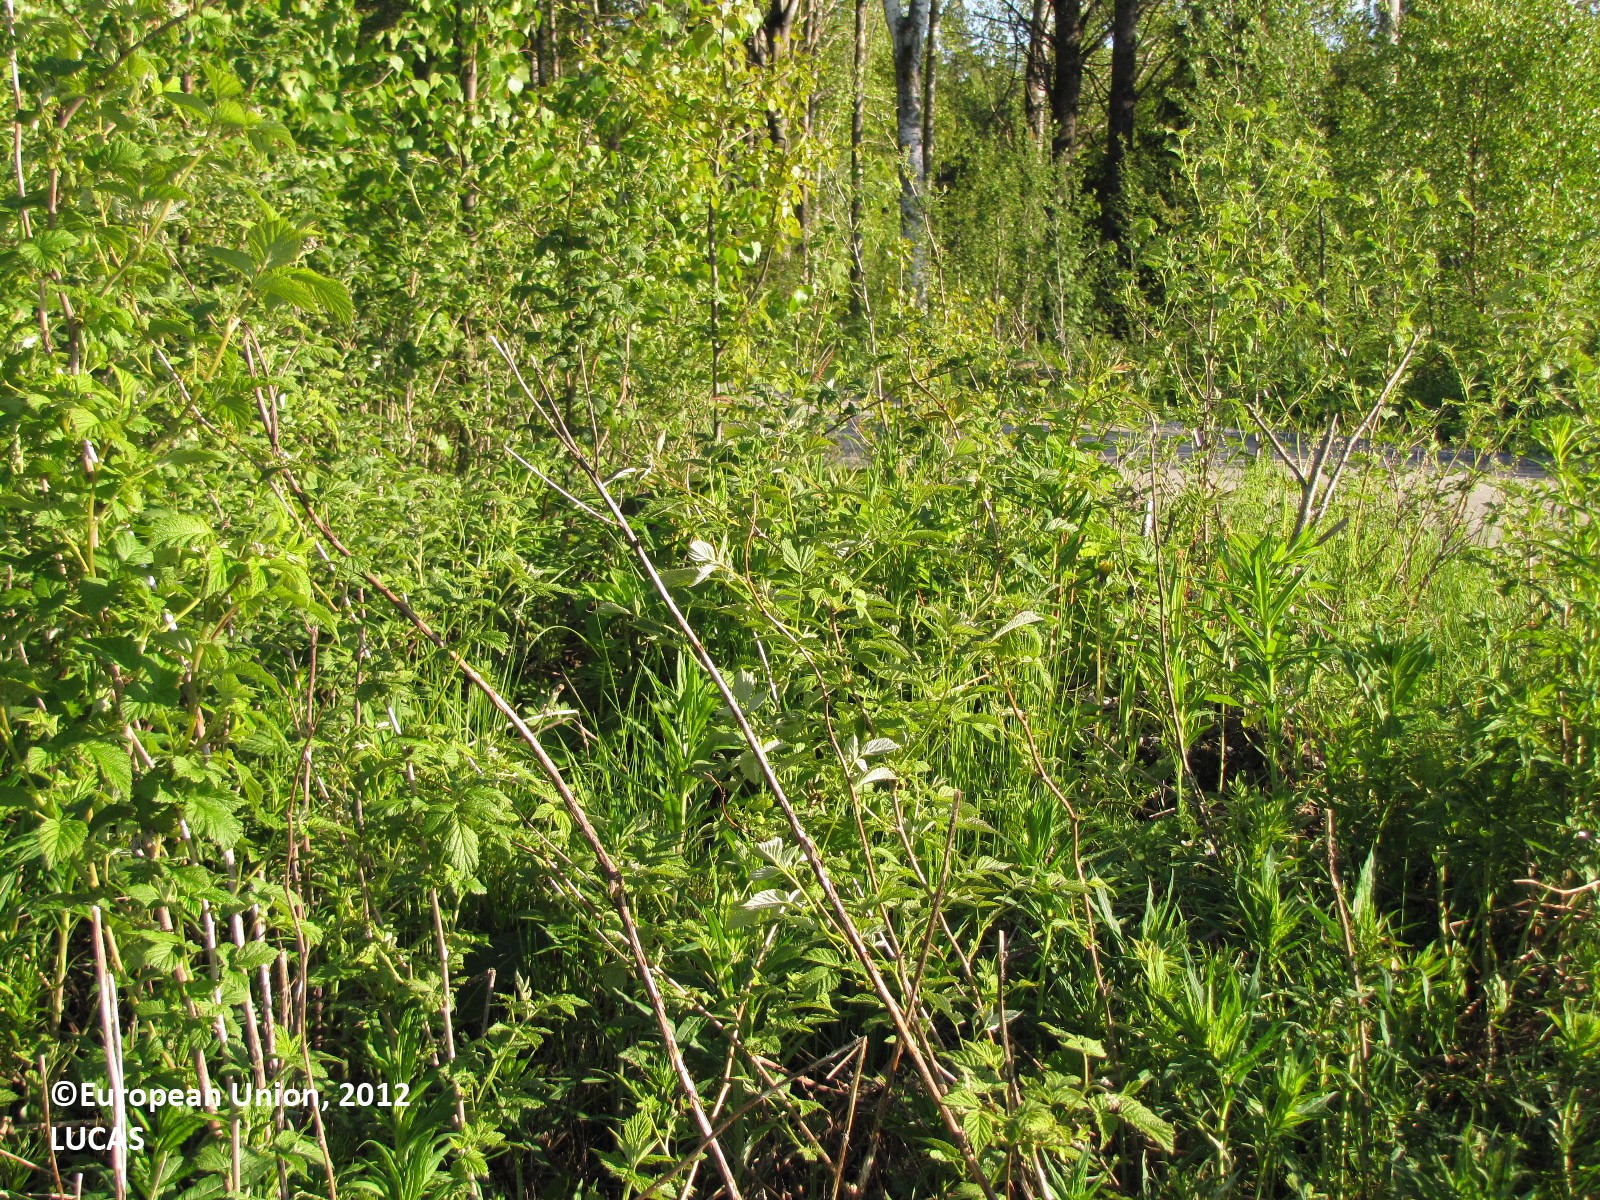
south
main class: Woodland
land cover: Broadleaved woodland
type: boreal forest
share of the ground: 25 - 50 %
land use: Forestry
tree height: < 5 m
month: June
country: FI
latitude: 61.3926
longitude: 22.9330
